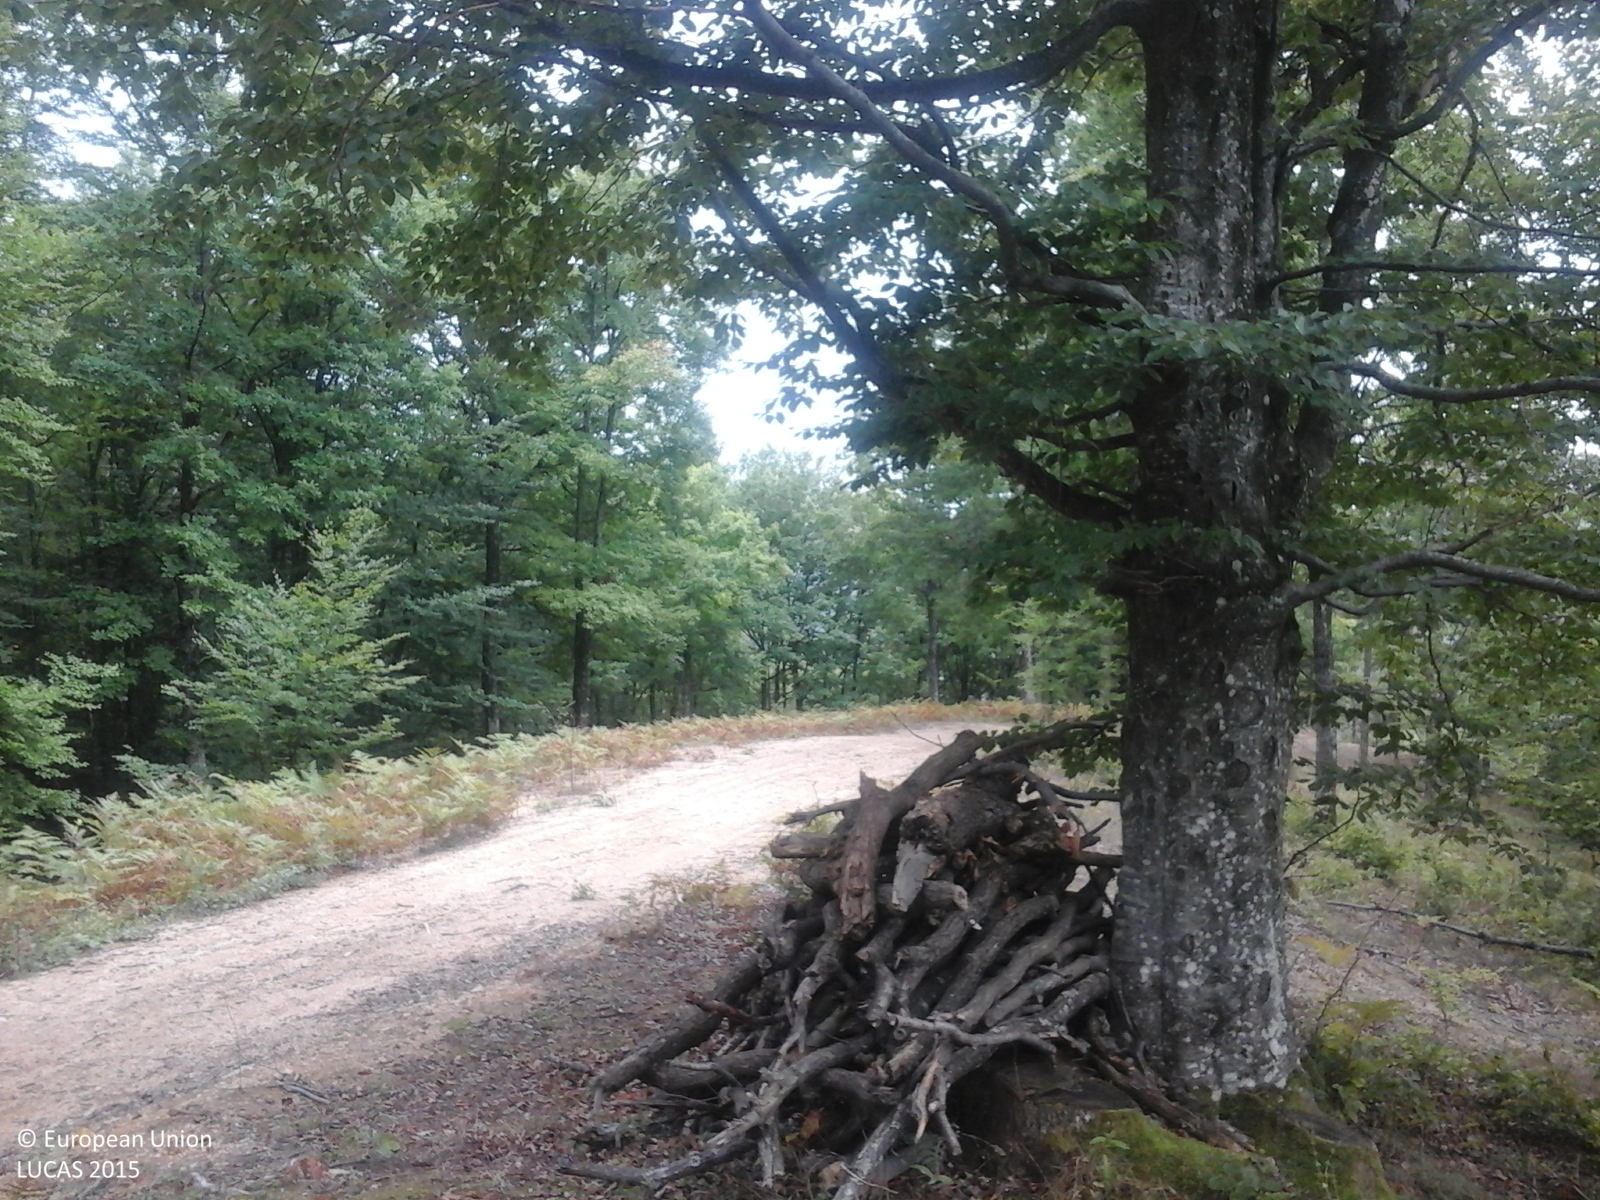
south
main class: Woodland
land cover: Broadleaved woodland
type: beech forest
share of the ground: > 75 %
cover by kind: broadleaved forest trees 100 %
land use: Forestry
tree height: > 5 m
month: September
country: RO
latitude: 45.0459
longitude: 22.8320
